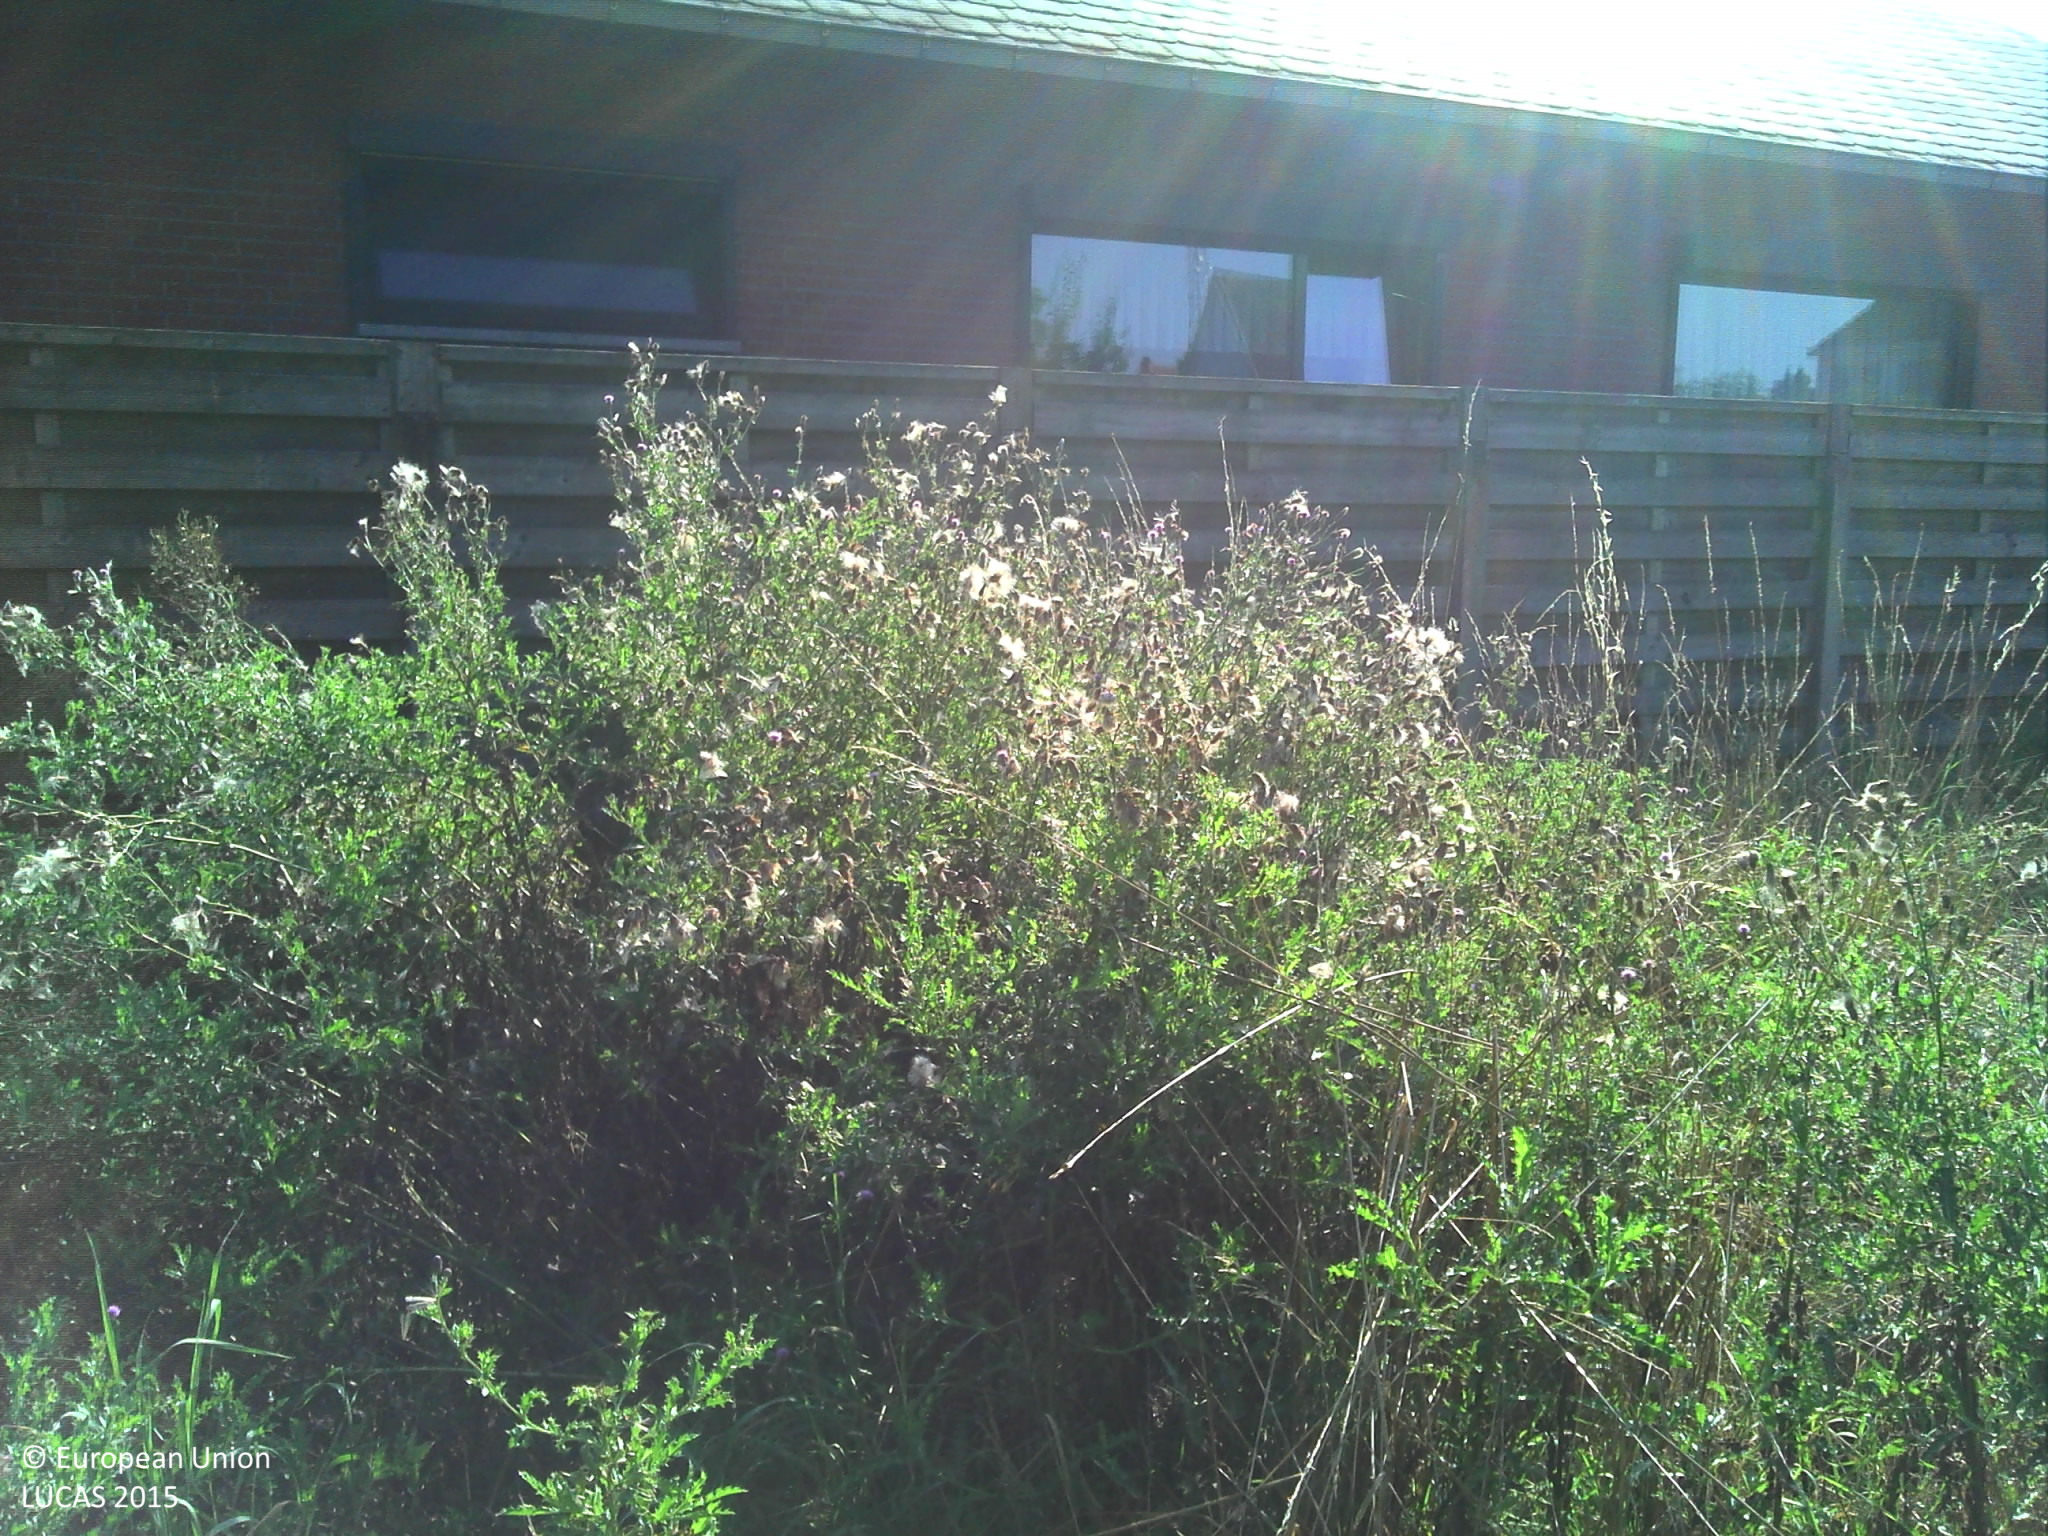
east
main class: Grassland
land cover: Spontaneously vegetated surfaces
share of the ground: > 75 %
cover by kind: herbaceous plants 100 %
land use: Residential
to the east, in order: Conifer hedges; Spontaneously vegetated surfaces; Artificial constructions in urban areas
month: August
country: BE
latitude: 51.1810
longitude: 5.1765
